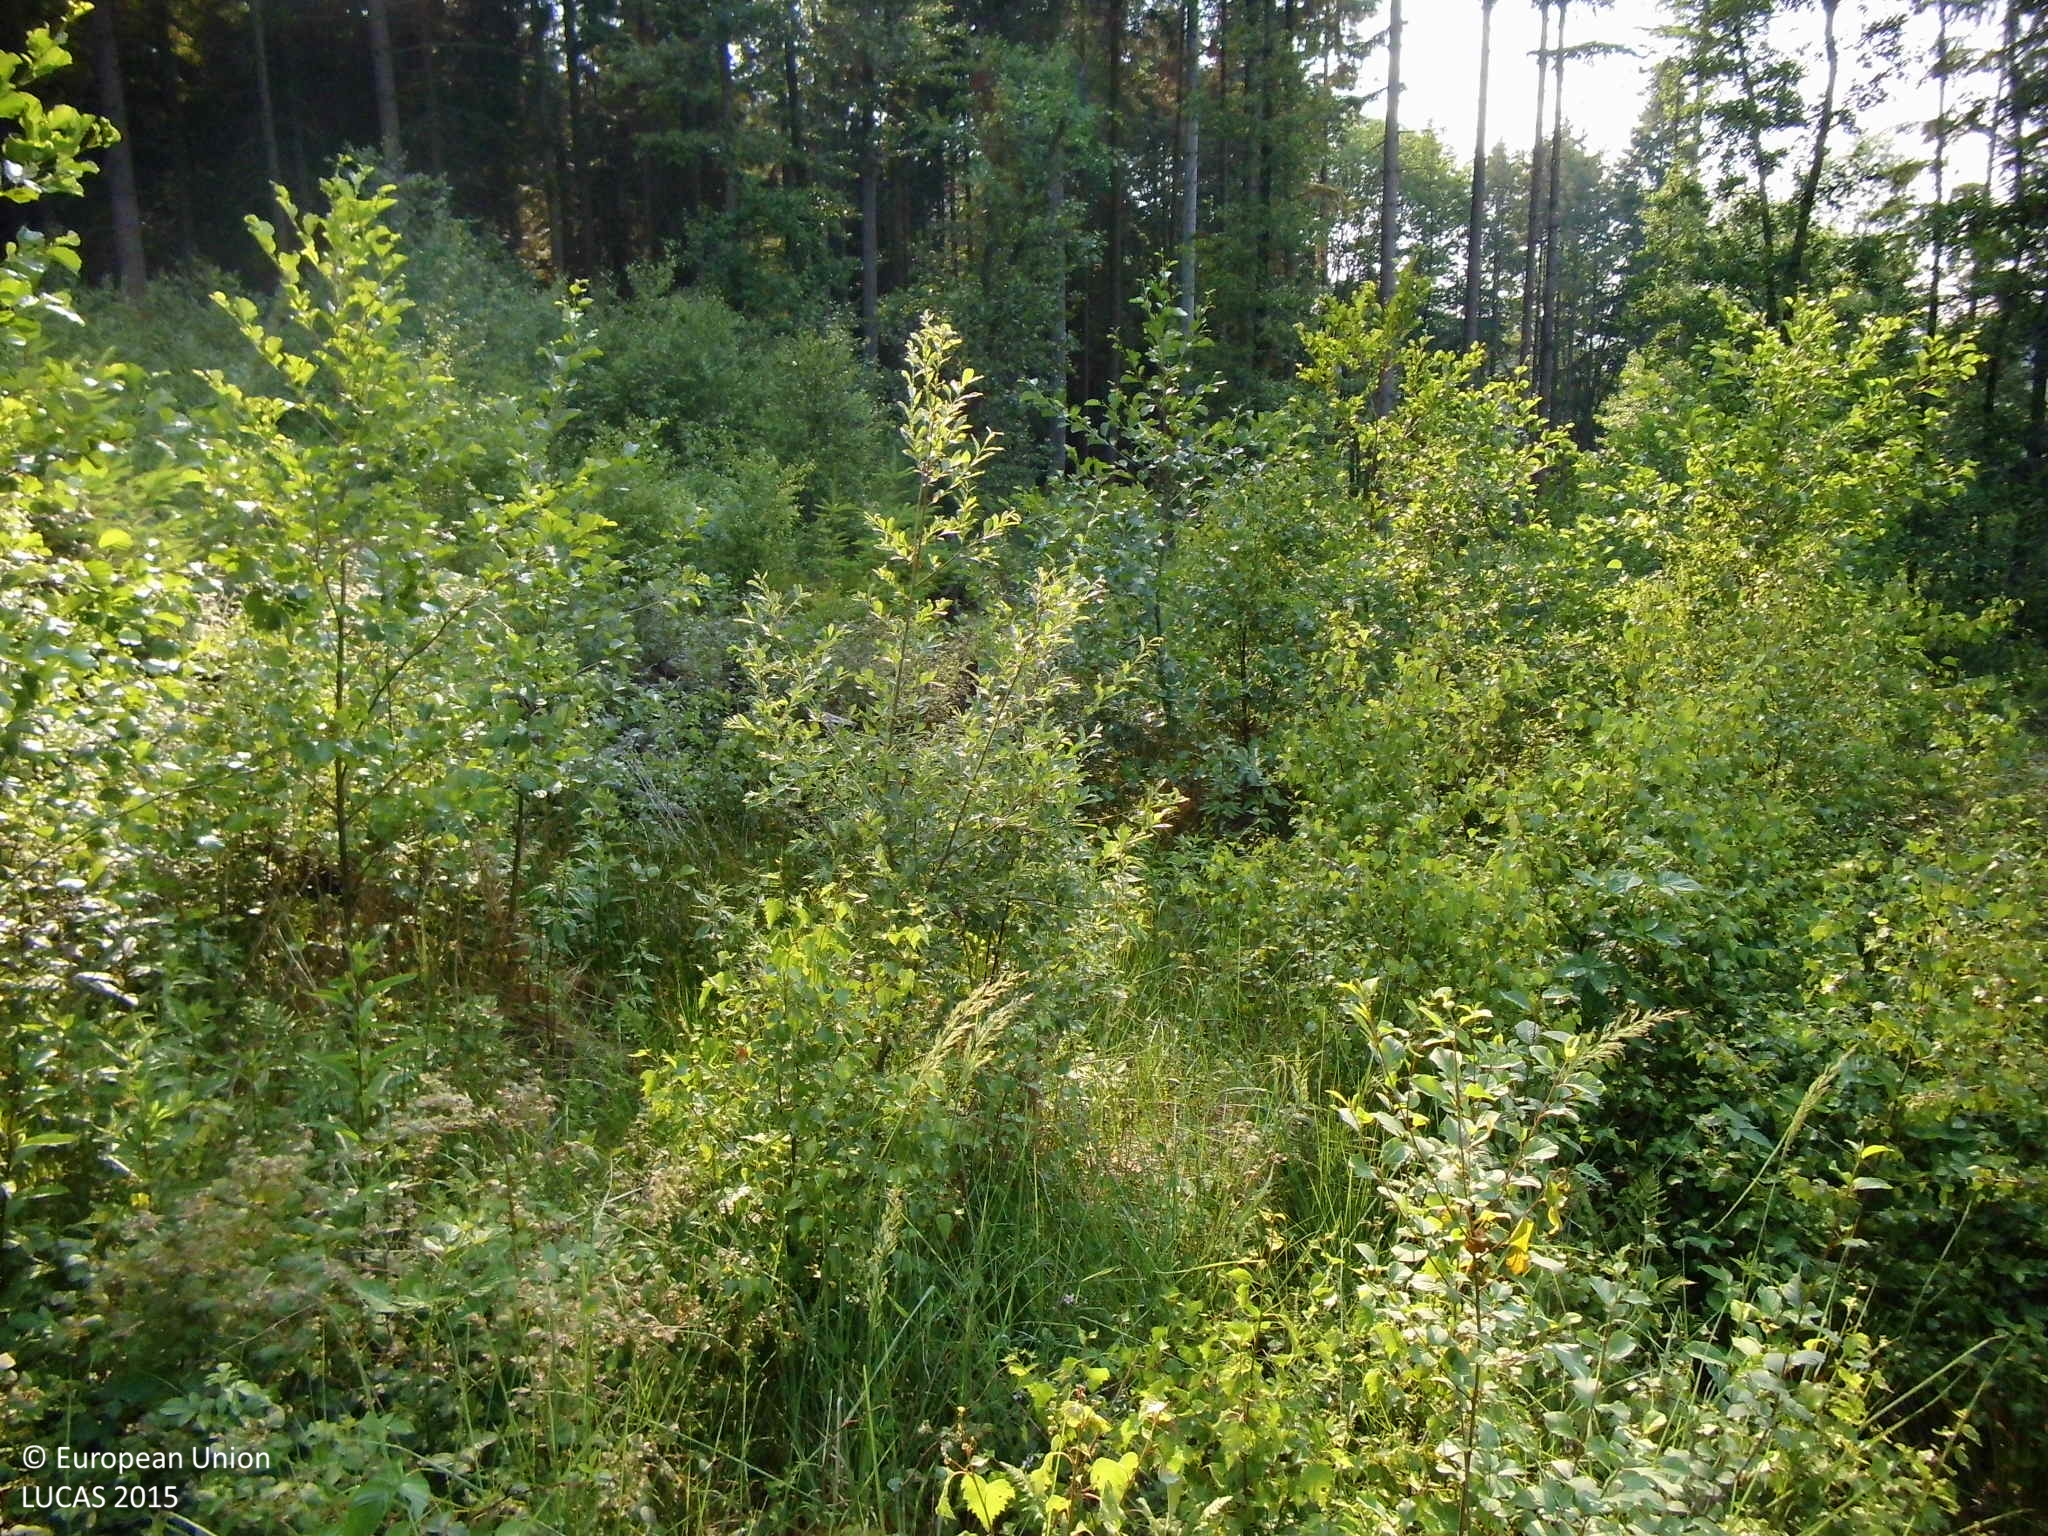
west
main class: Shrubland
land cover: Shrubland with sparse tree cover
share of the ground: 50 - 75 %
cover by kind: shrubs 50 %, herbaceous plants 35 %, broadleaved forest trees 5 %, lichens and mosses 5 %, unconsolidated bare surface 5 %
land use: Forestry
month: July
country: DE
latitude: 51.3538
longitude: 8.0044
